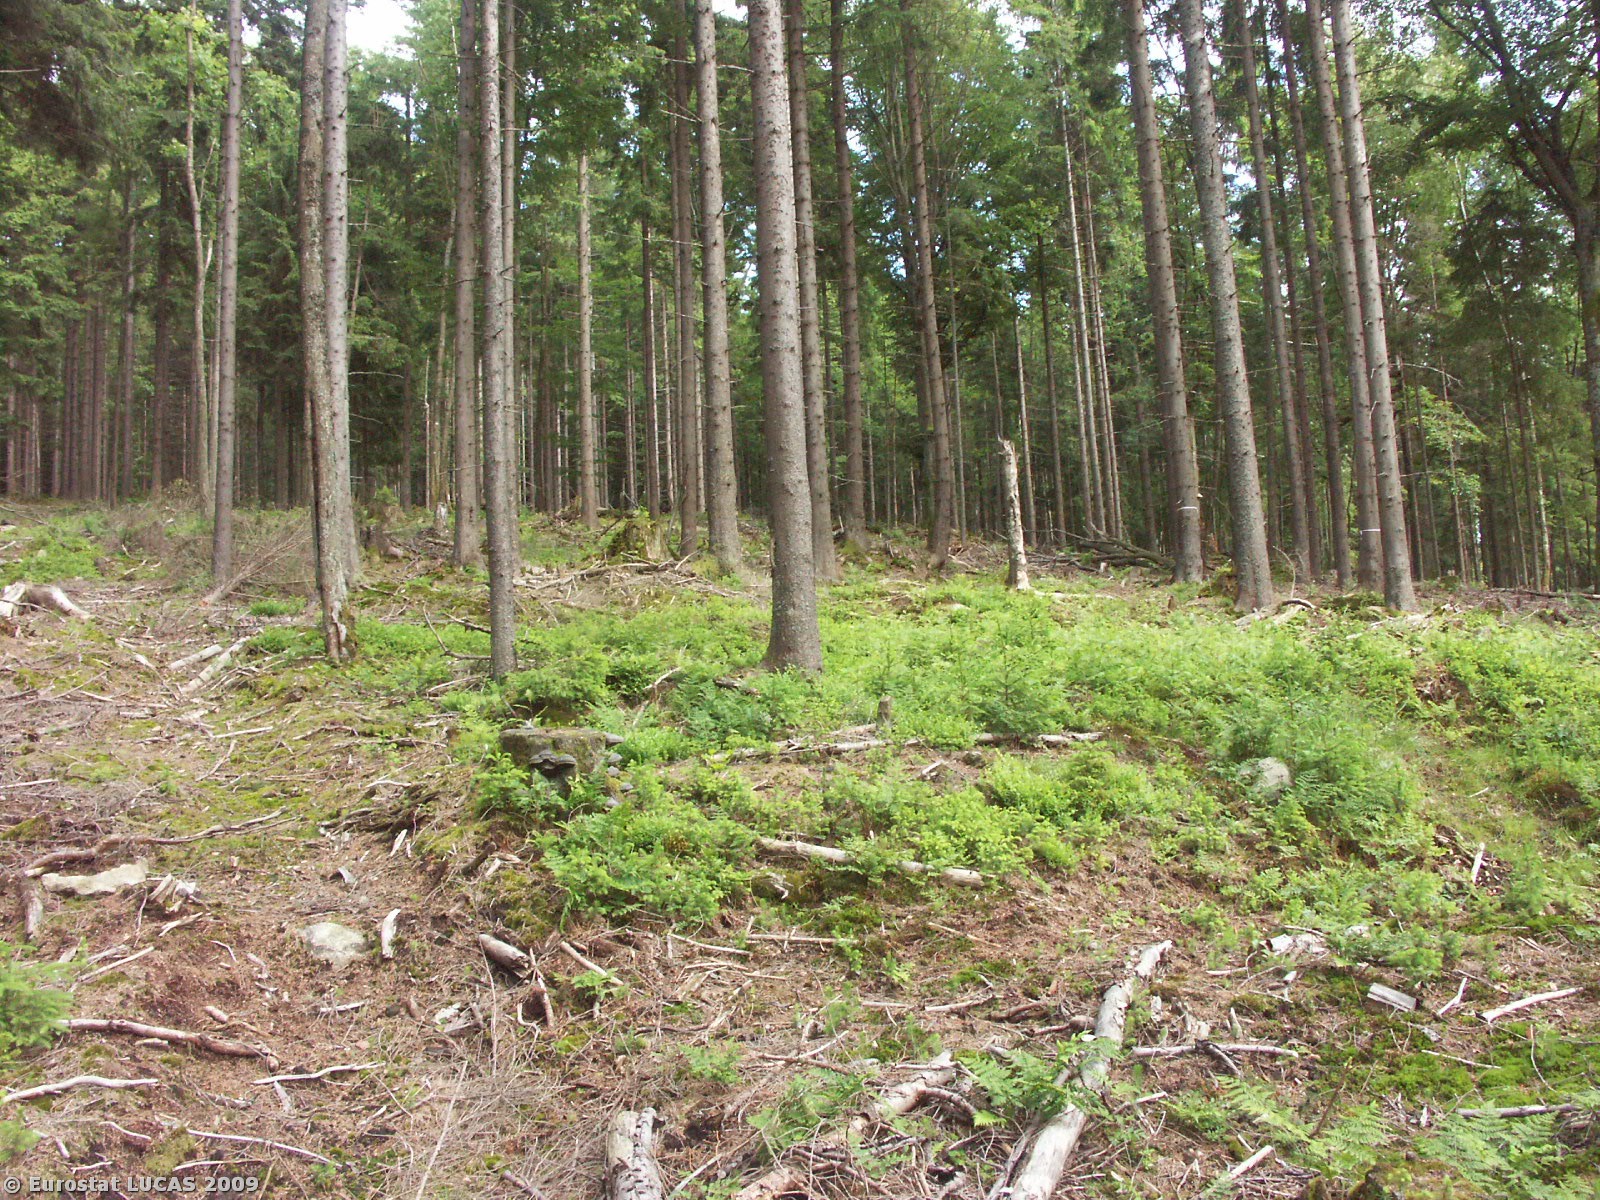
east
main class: Woodland
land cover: Coniferous woodland
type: hemiboreal forest and nemoral coniferous forest and mixed broadleaved-coniferous forest
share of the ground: > 75 %
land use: Forestry
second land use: Nature reserves
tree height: > 5 m
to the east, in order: Coniferous woodland; Mixed woodland
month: June
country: CZ
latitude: 48.6523
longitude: 14.0862
